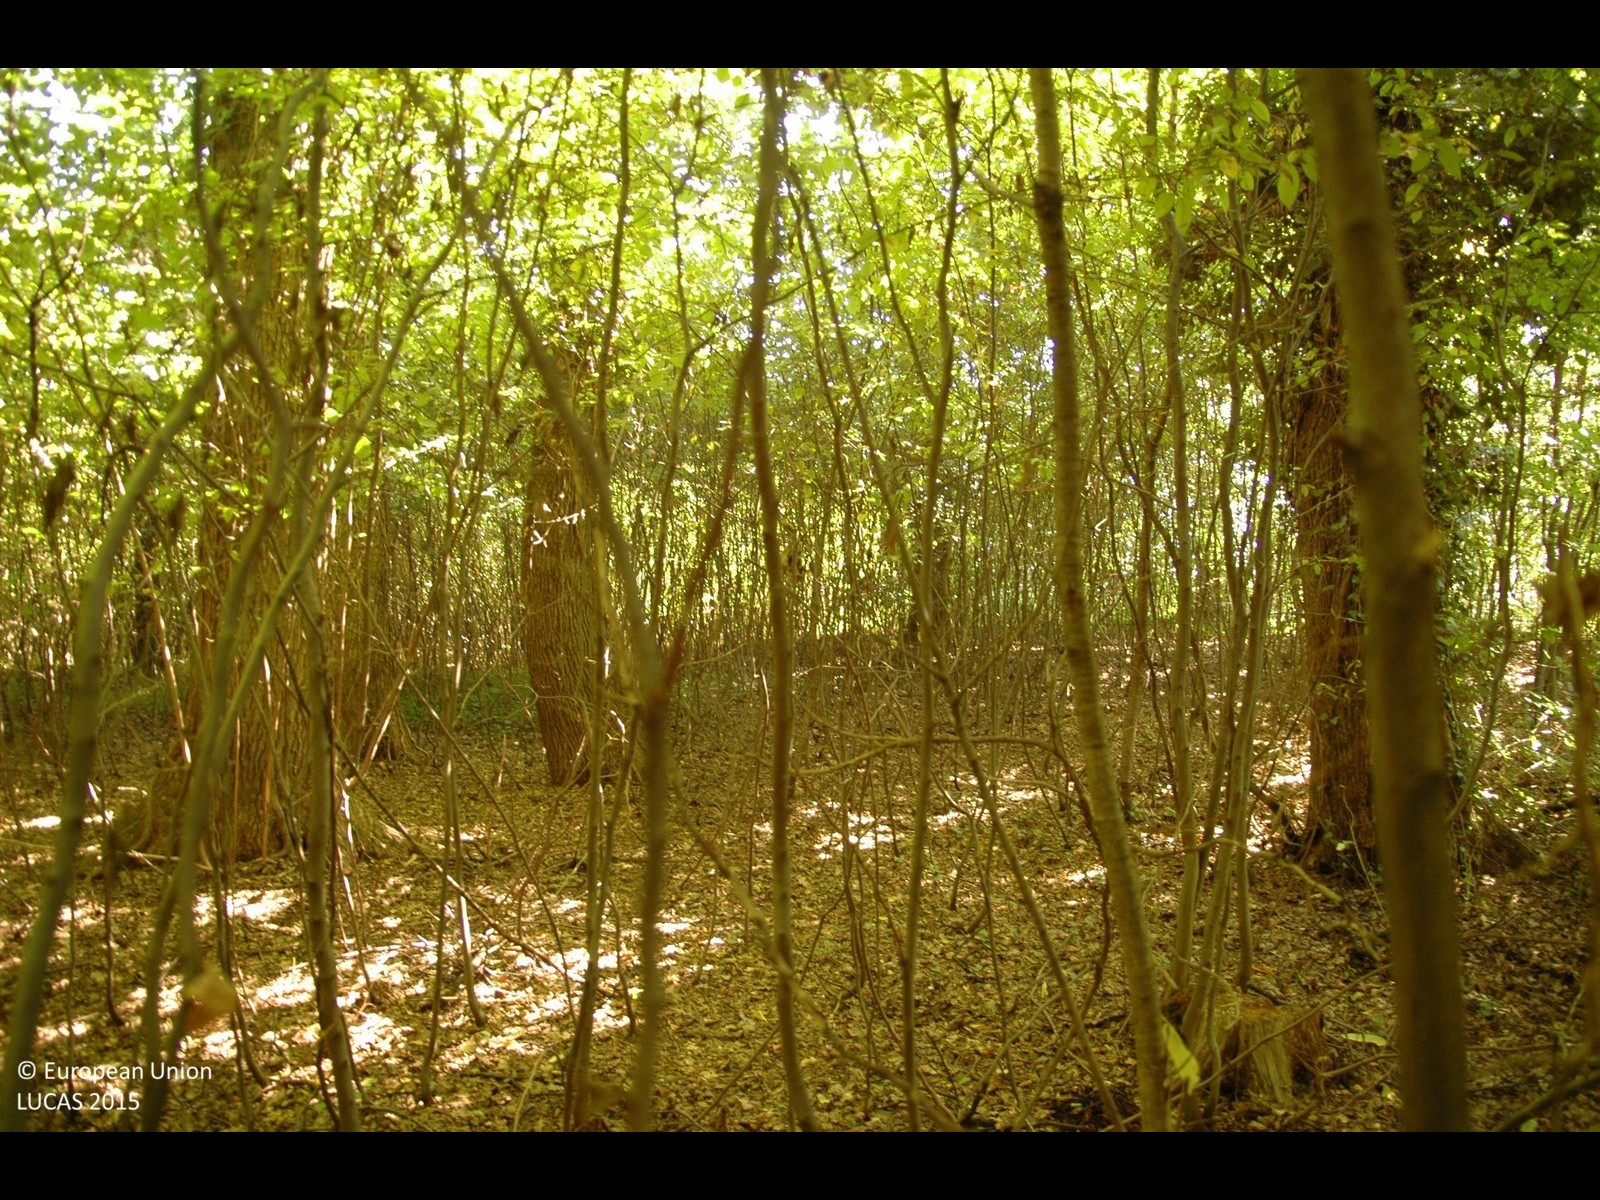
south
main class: Woodland
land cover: Broadleaved woodland
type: mesophytic deciduous forest
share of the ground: > 75 %
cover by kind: broadleaved forest trees 100 %
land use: Semi-natural and natural areas not in use
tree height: > 5 m
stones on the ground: < 10 %
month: August
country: HR
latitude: 46.1529
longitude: 16.7989
